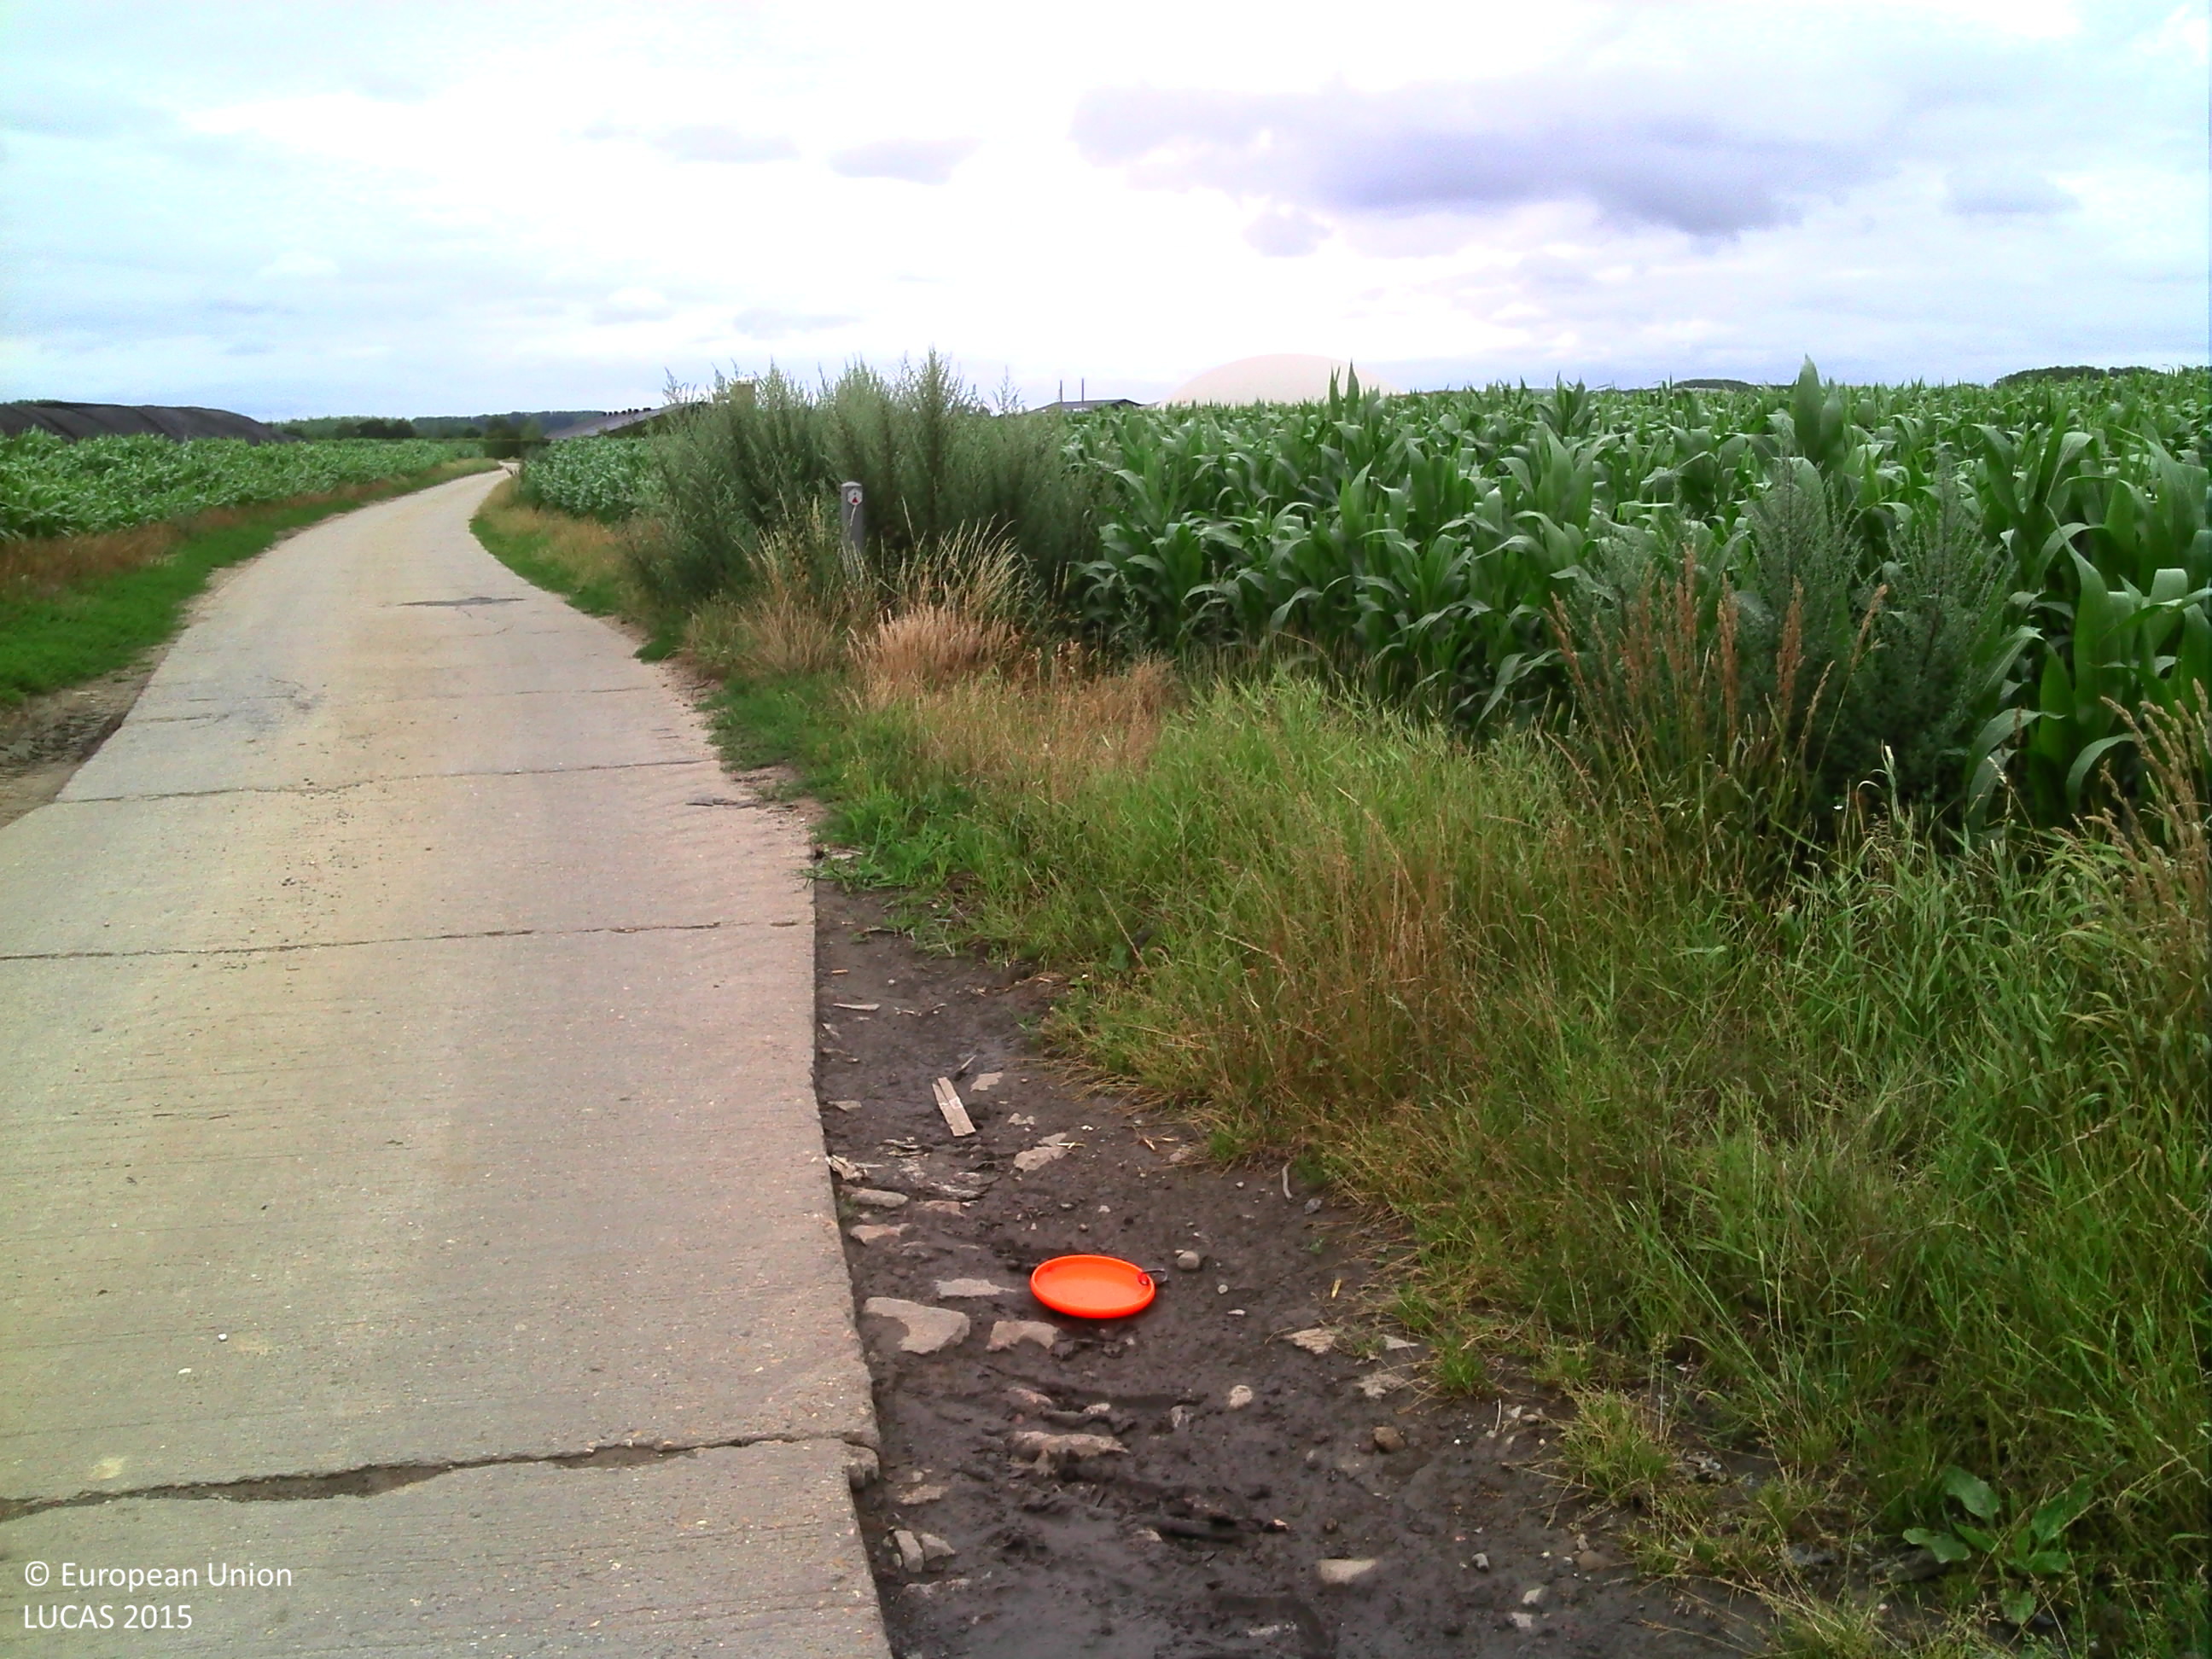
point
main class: Cropland
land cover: Maize
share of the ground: > 75 %
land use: Agriculture (excluding fallow land and kitchen gardens)
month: July
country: BE
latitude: 50.8494
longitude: 5.4387
